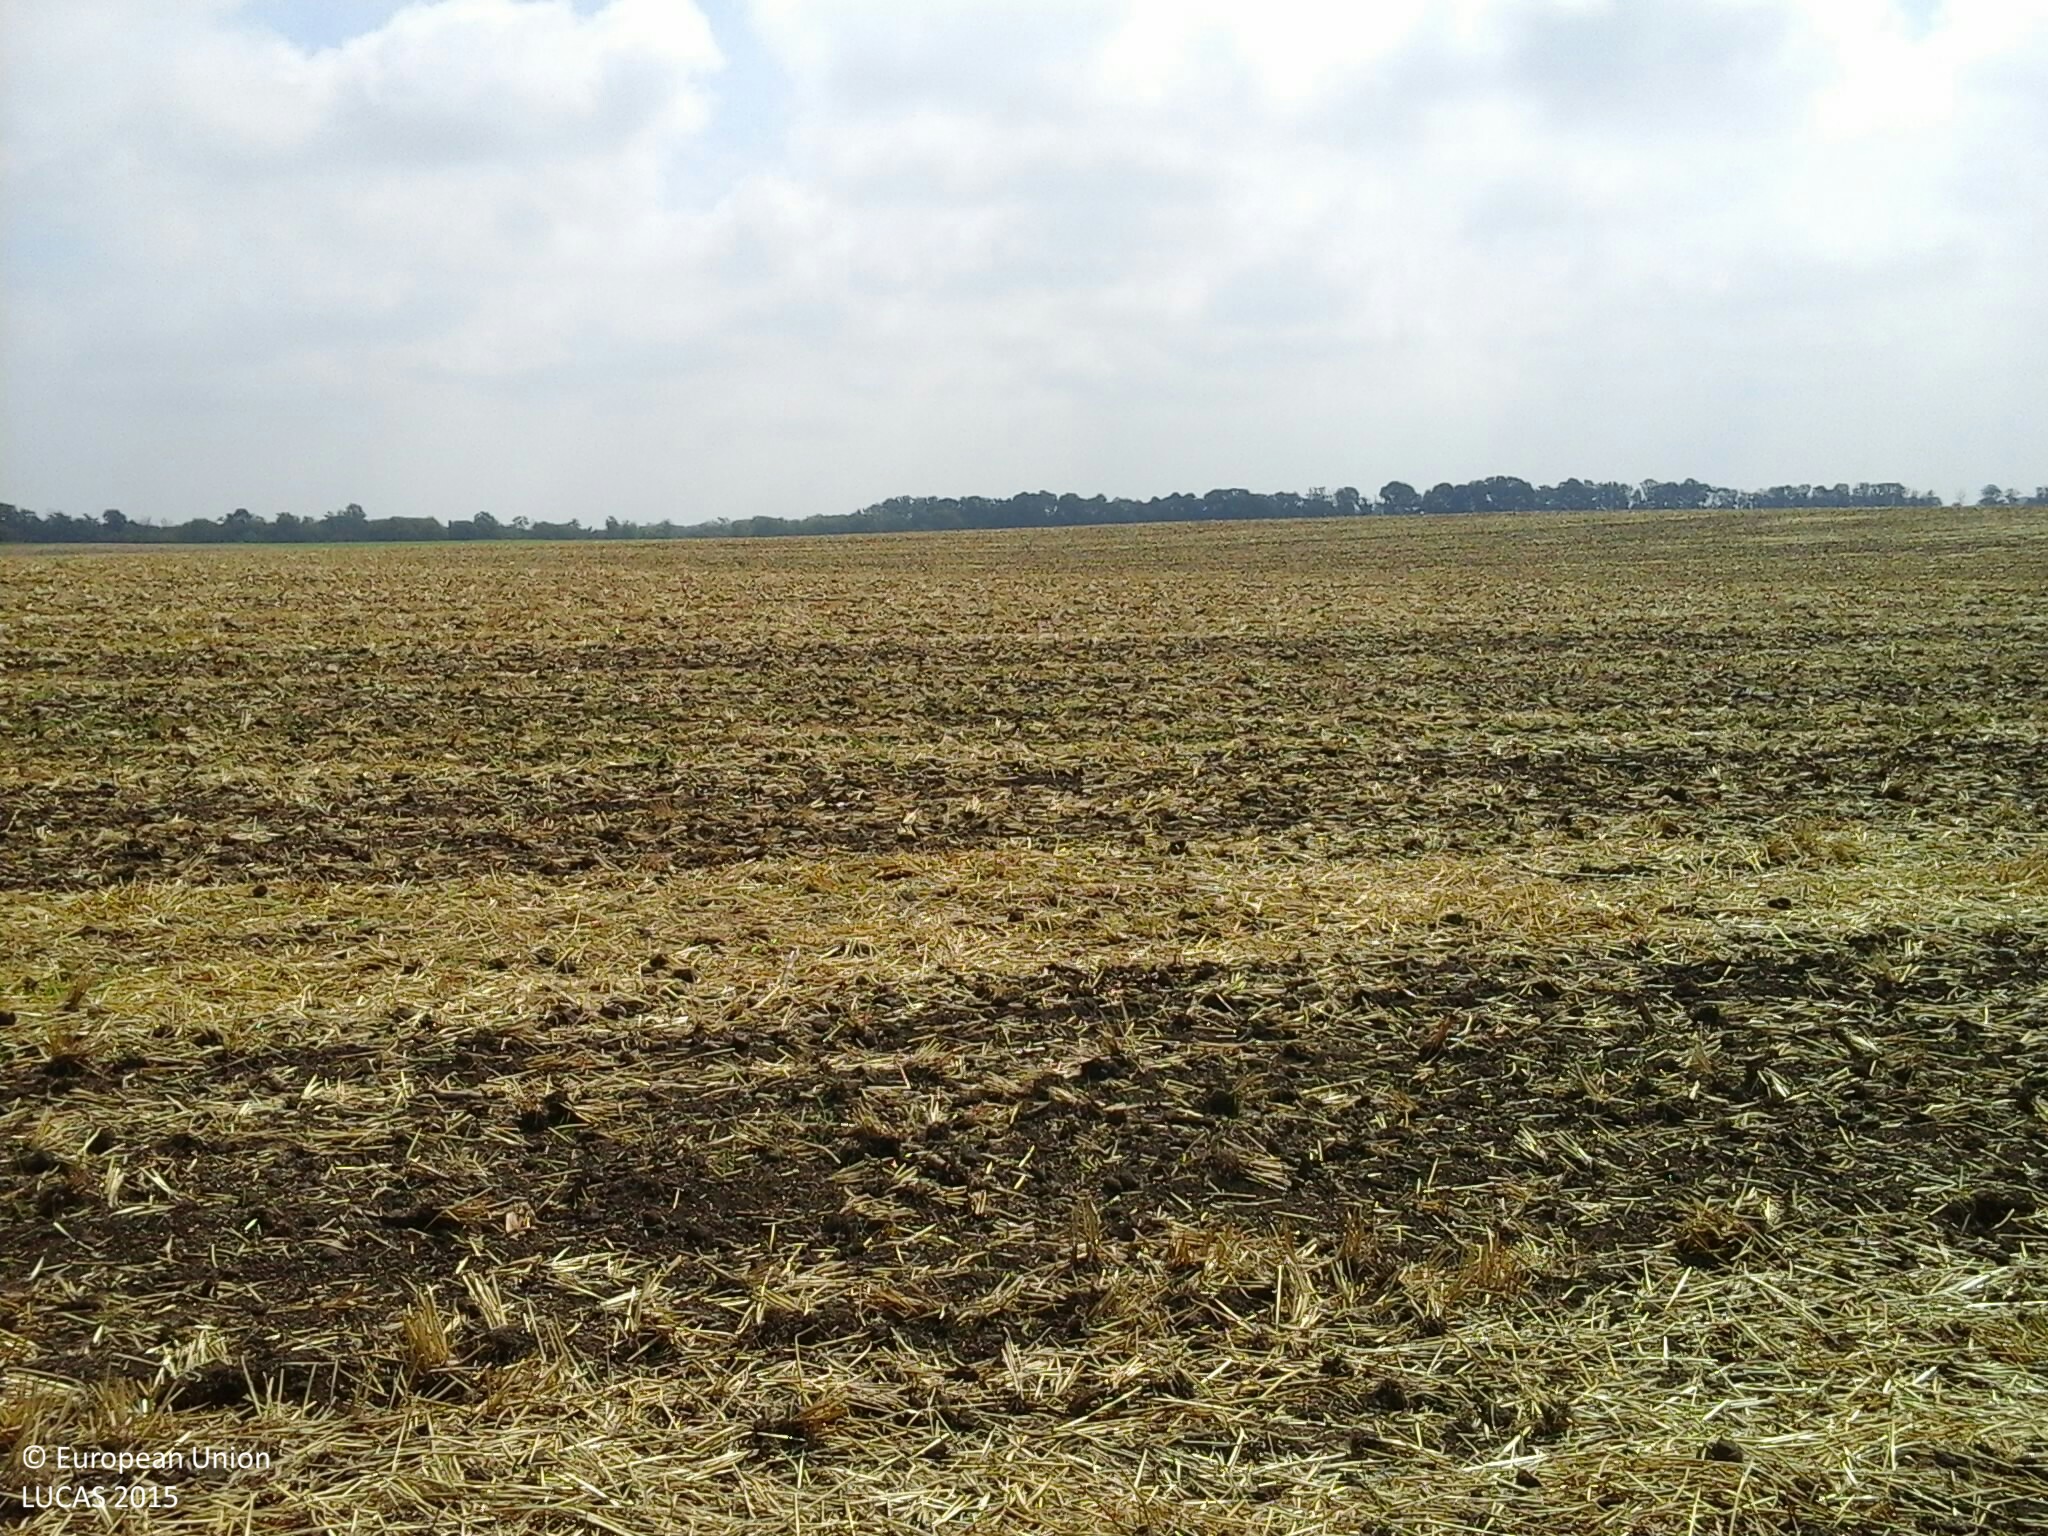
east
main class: Cropland
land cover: Common wheat
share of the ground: 10 - 25 %
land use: Agriculture (excluding fallow land and kitchen gardens)
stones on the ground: < 10 %
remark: Harvested field
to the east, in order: Common wheat
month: July
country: HU
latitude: 47.9119
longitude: 21.4843
